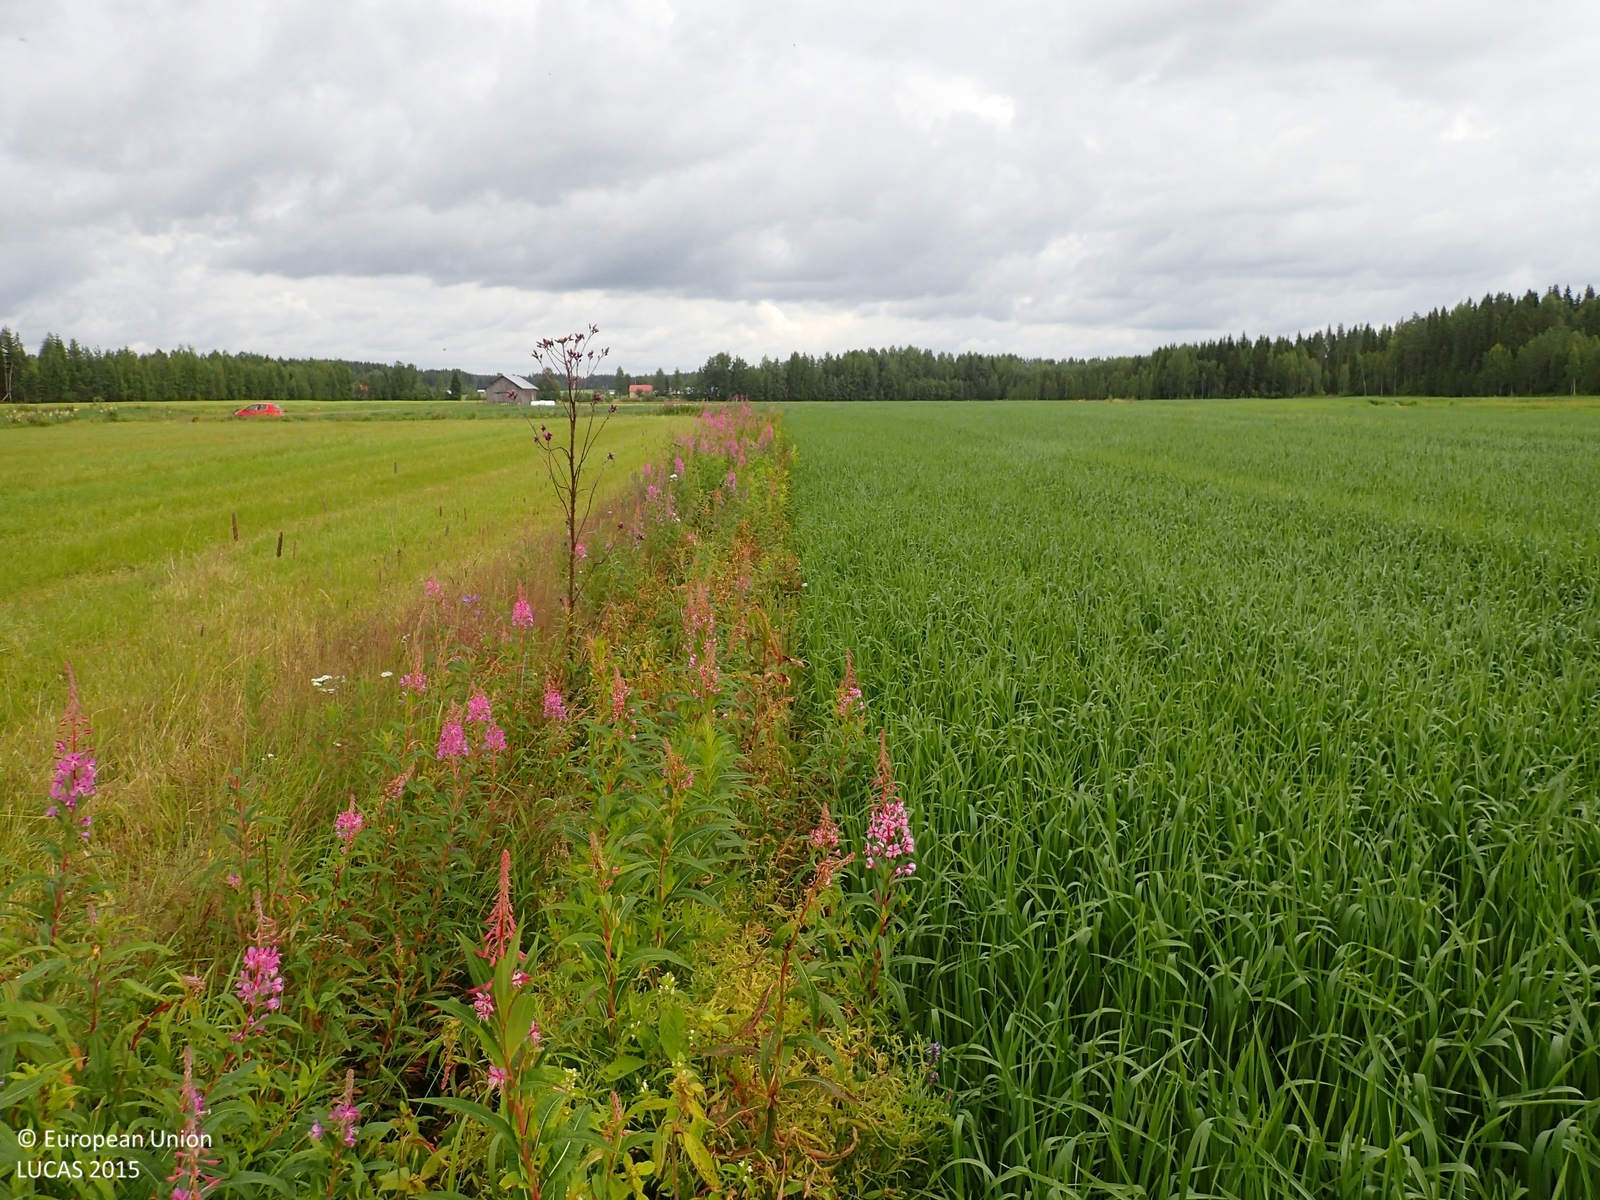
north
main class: Cropland
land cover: Oats
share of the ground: > 75 %
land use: Agriculture (excluding fallow land and kitchen gardens)
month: July
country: FI
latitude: 62.9163
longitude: 23.3139
